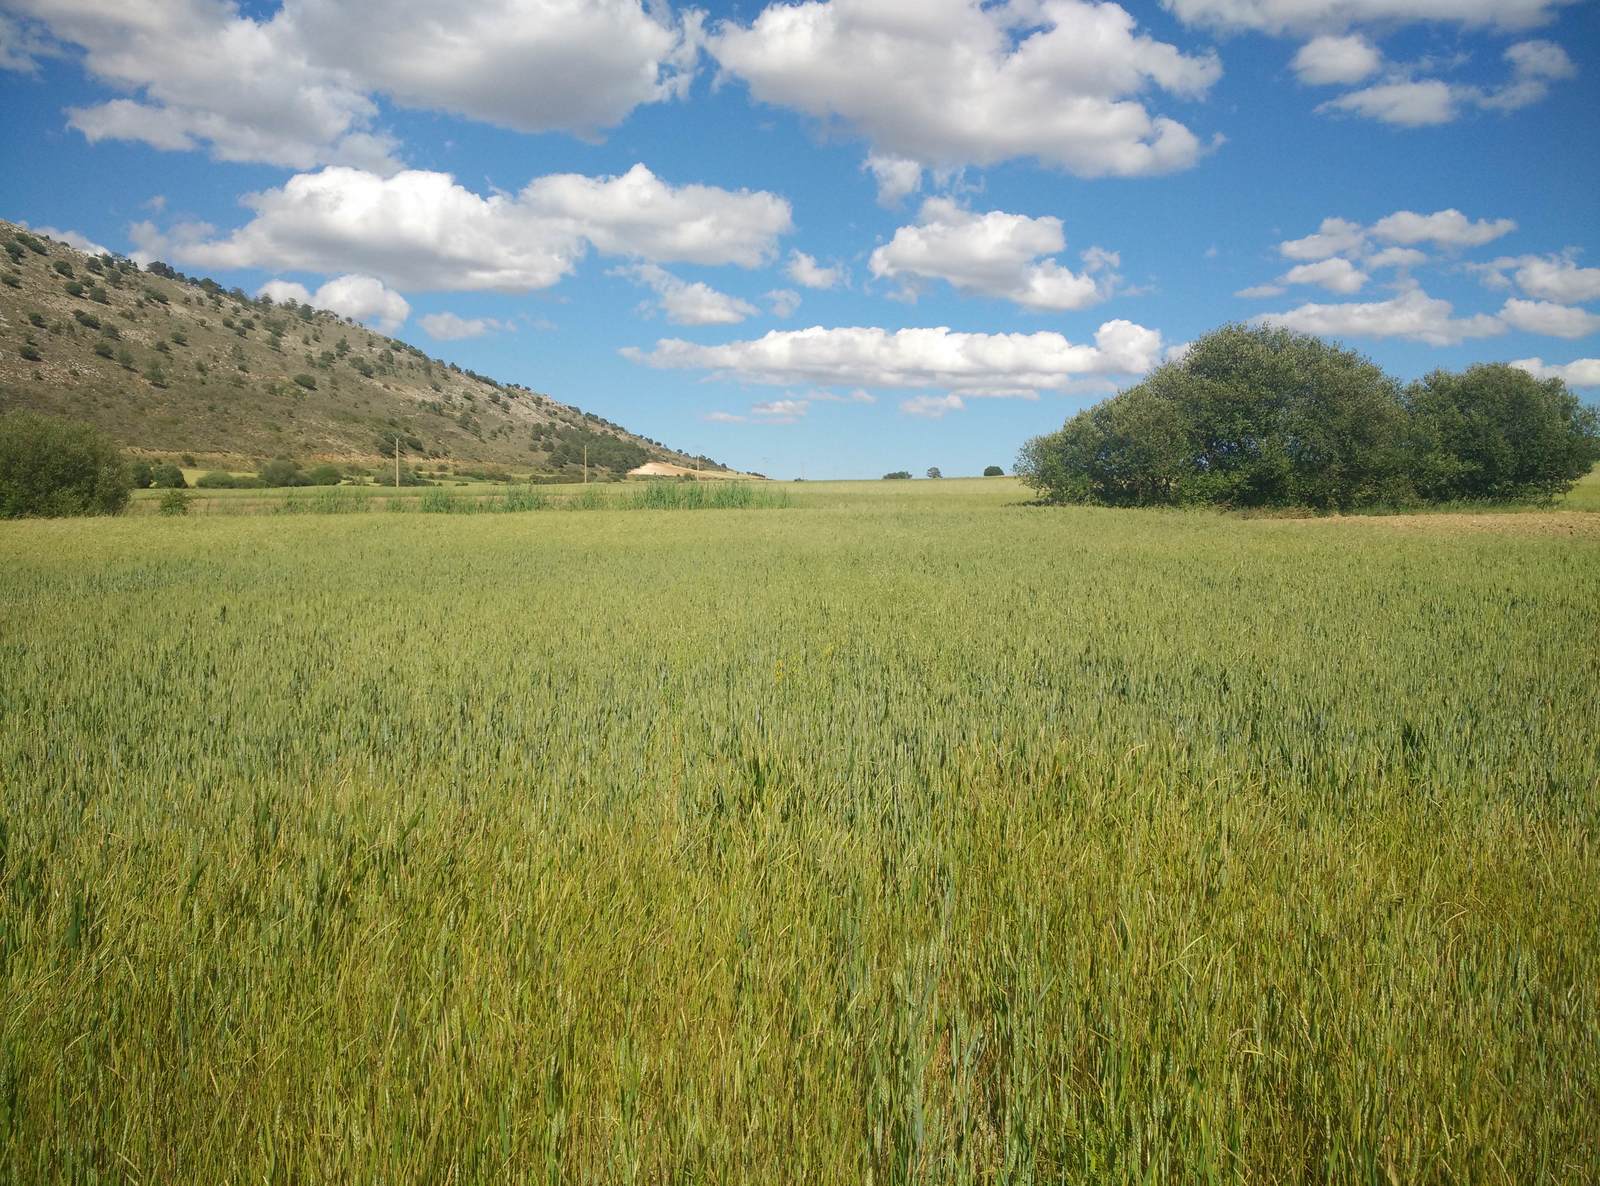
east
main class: Cropland
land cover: Common wheat
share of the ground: > 75 %
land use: Agriculture (excluding fallow land and kitchen gardens)
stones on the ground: 10 - 25 %
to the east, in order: Common wheat; Ditches and canals; Shruby margins; Common wheat; Grass margins; Other bare soil; Common wheat; Ditches and canals; Grass margins; Common wheat
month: June
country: ES
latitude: 40.6198
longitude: -1.7328
